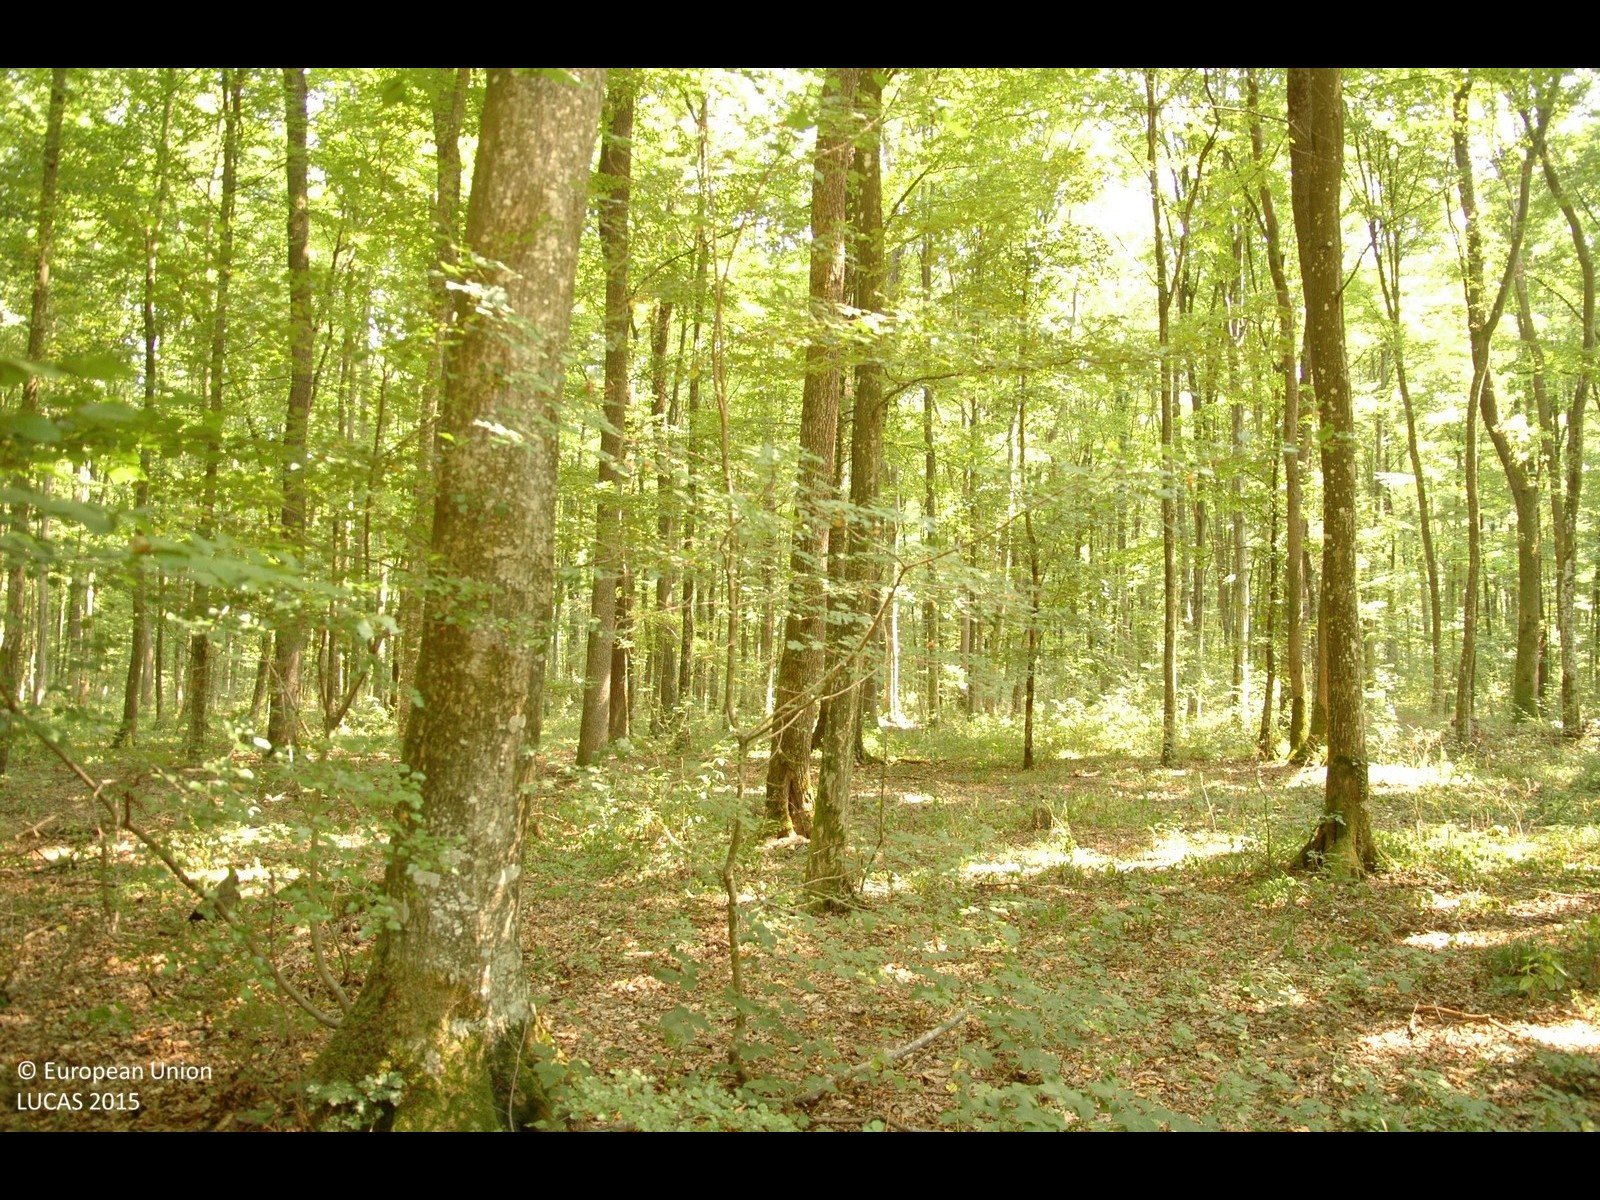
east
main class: Woodland
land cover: Broadleaved woodland
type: mesophytic deciduous forest
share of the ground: > 75 %
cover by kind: broadleaved forest trees 100 %
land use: Forestry
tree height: > 5 m
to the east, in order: Broadleaved woodland
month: August
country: HR
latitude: 46.0344
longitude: 17.2248
